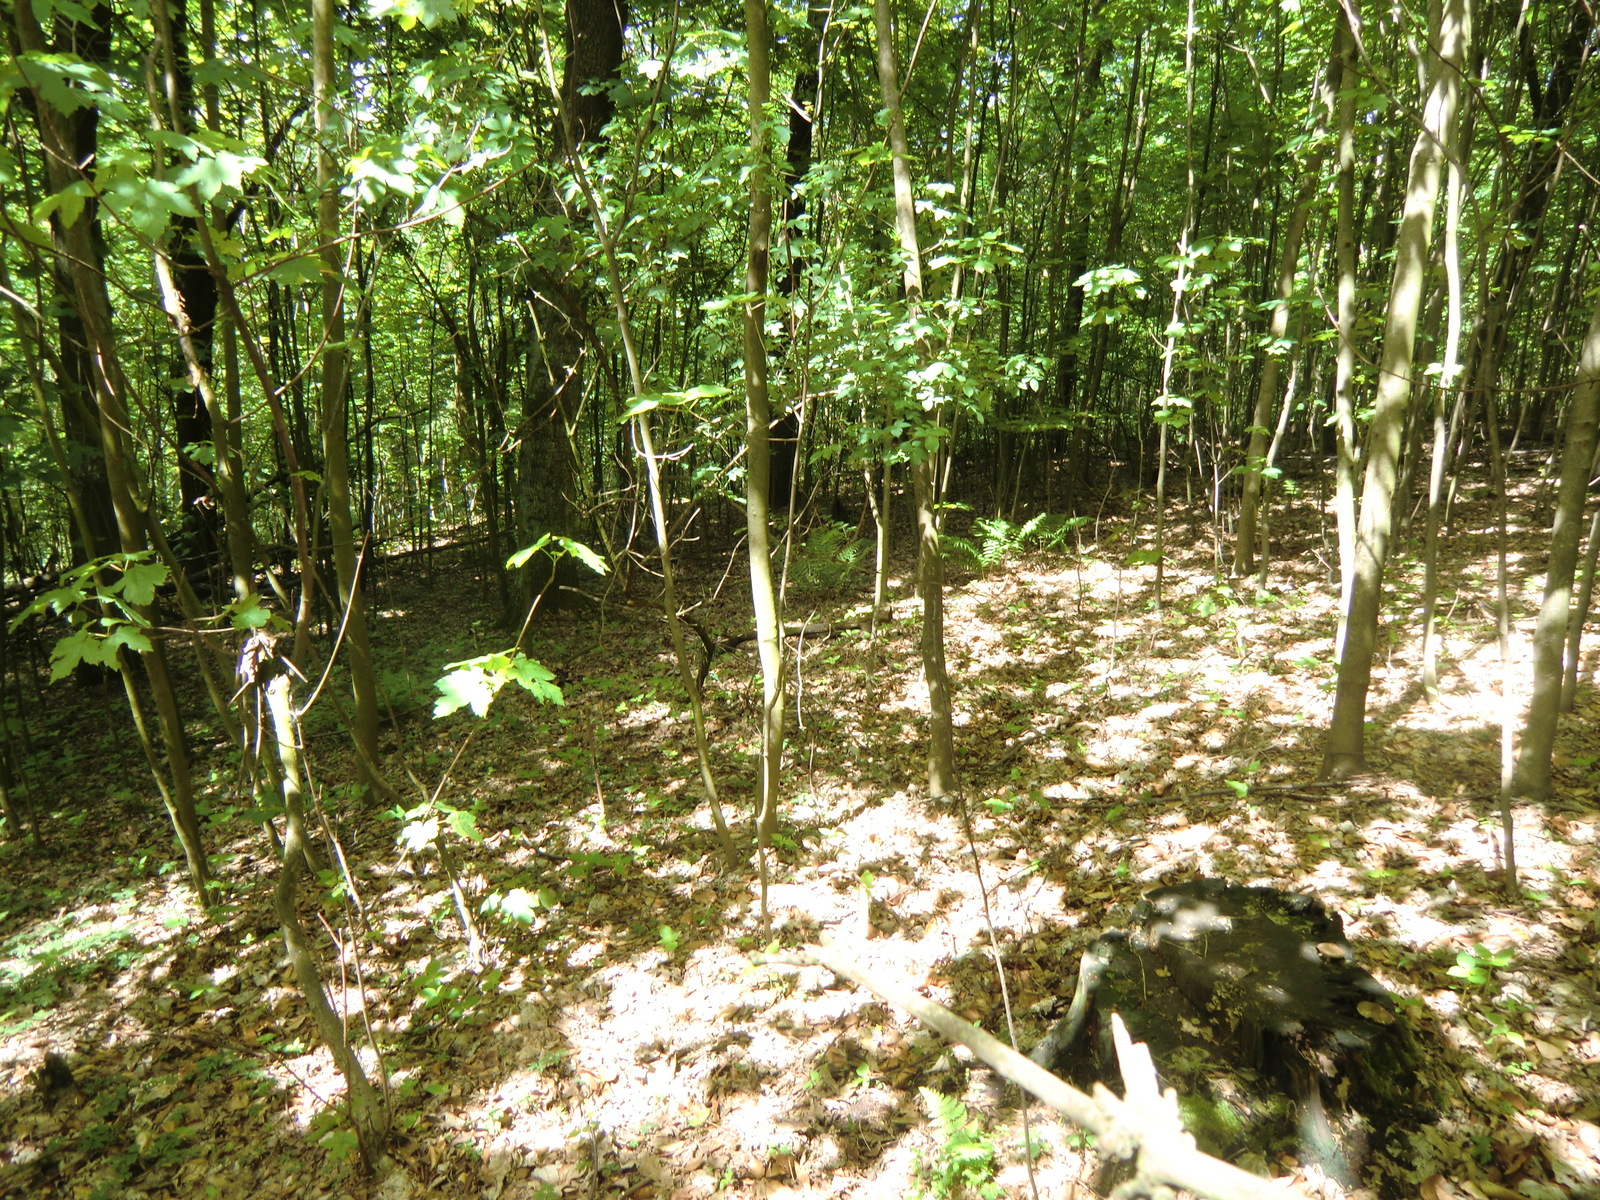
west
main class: Woodland
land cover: Broadleaved woodland
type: hemiboreal forest and nemoral coniferous forest and mixed broadleaved-coniferous forest
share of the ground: > 75 %
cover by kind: broadleaved forest trees 50 %, unconsolidated bare surface 50 %
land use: Forestry
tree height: > 5 m
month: May
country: AT
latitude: 48.2976
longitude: 14.4083
